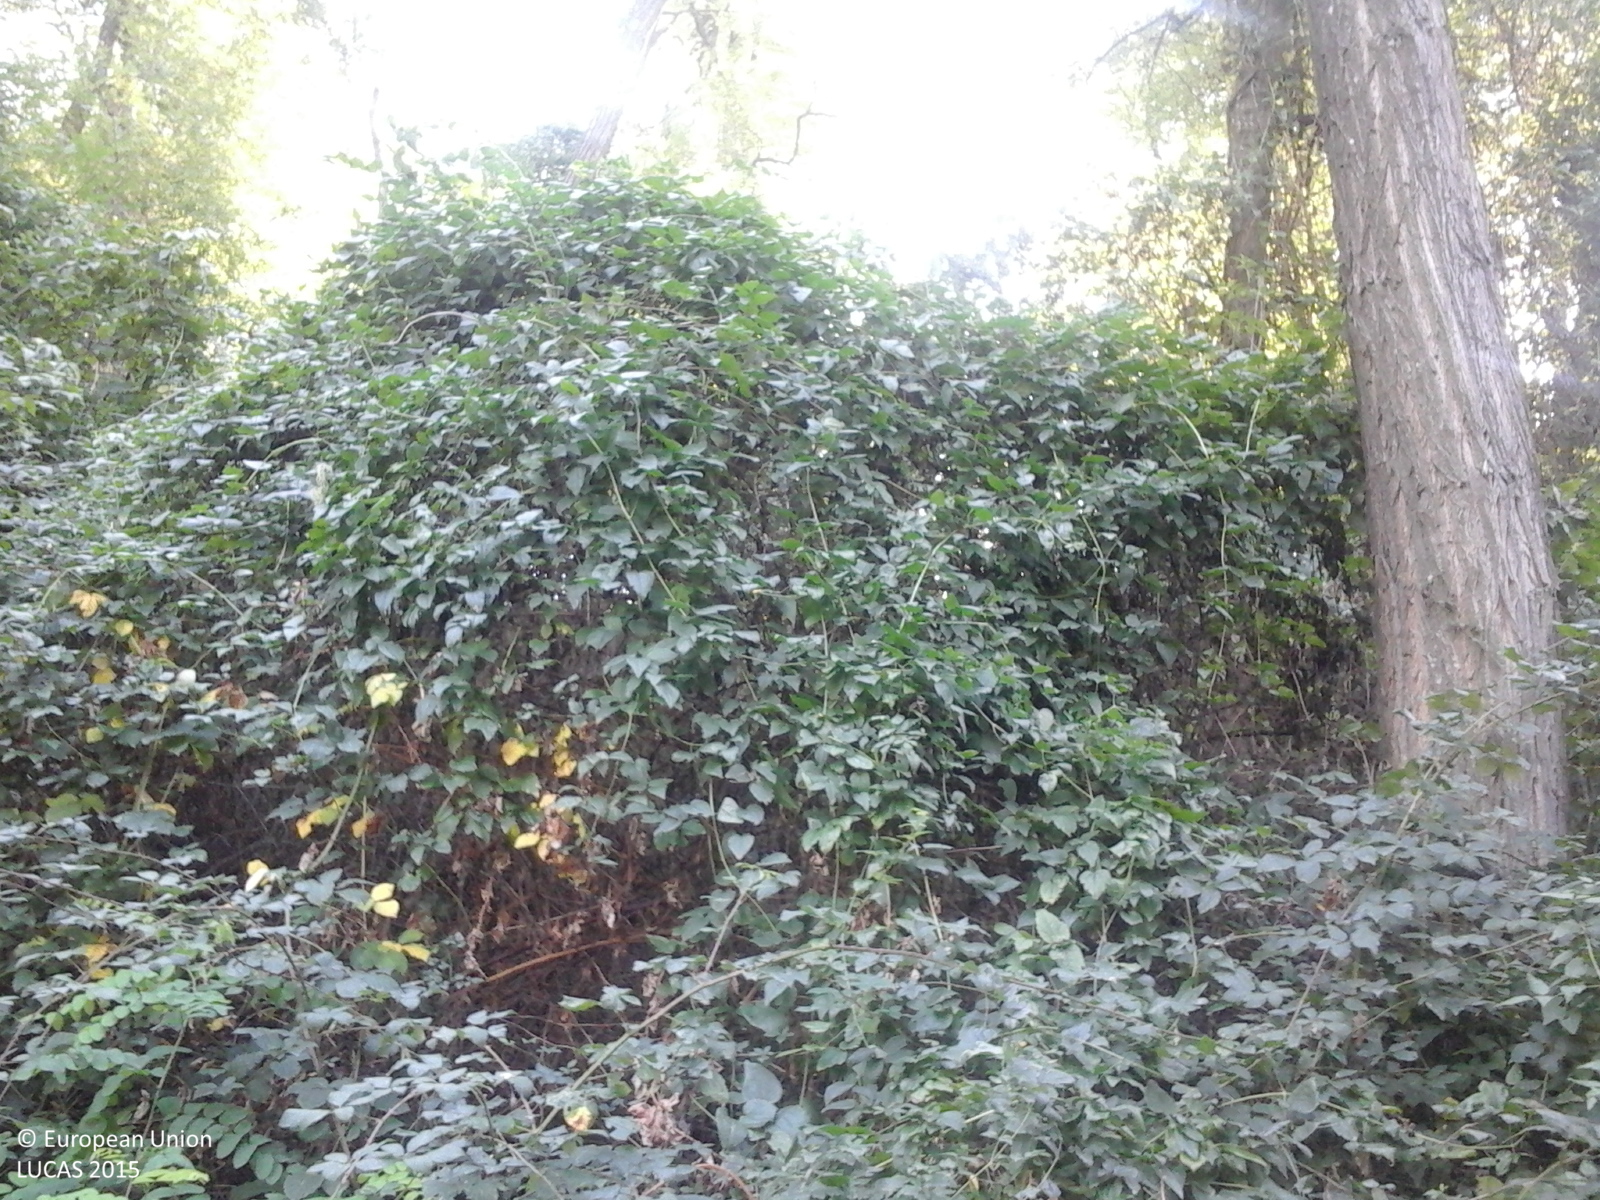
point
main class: Woodland
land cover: Broadleaved woodland
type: exotic forest
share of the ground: > 75 %
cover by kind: broadleaved forest trees 100 %
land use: Forestry
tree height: > 5 m
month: September
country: RO
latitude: 45.0887
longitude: 22.3264
